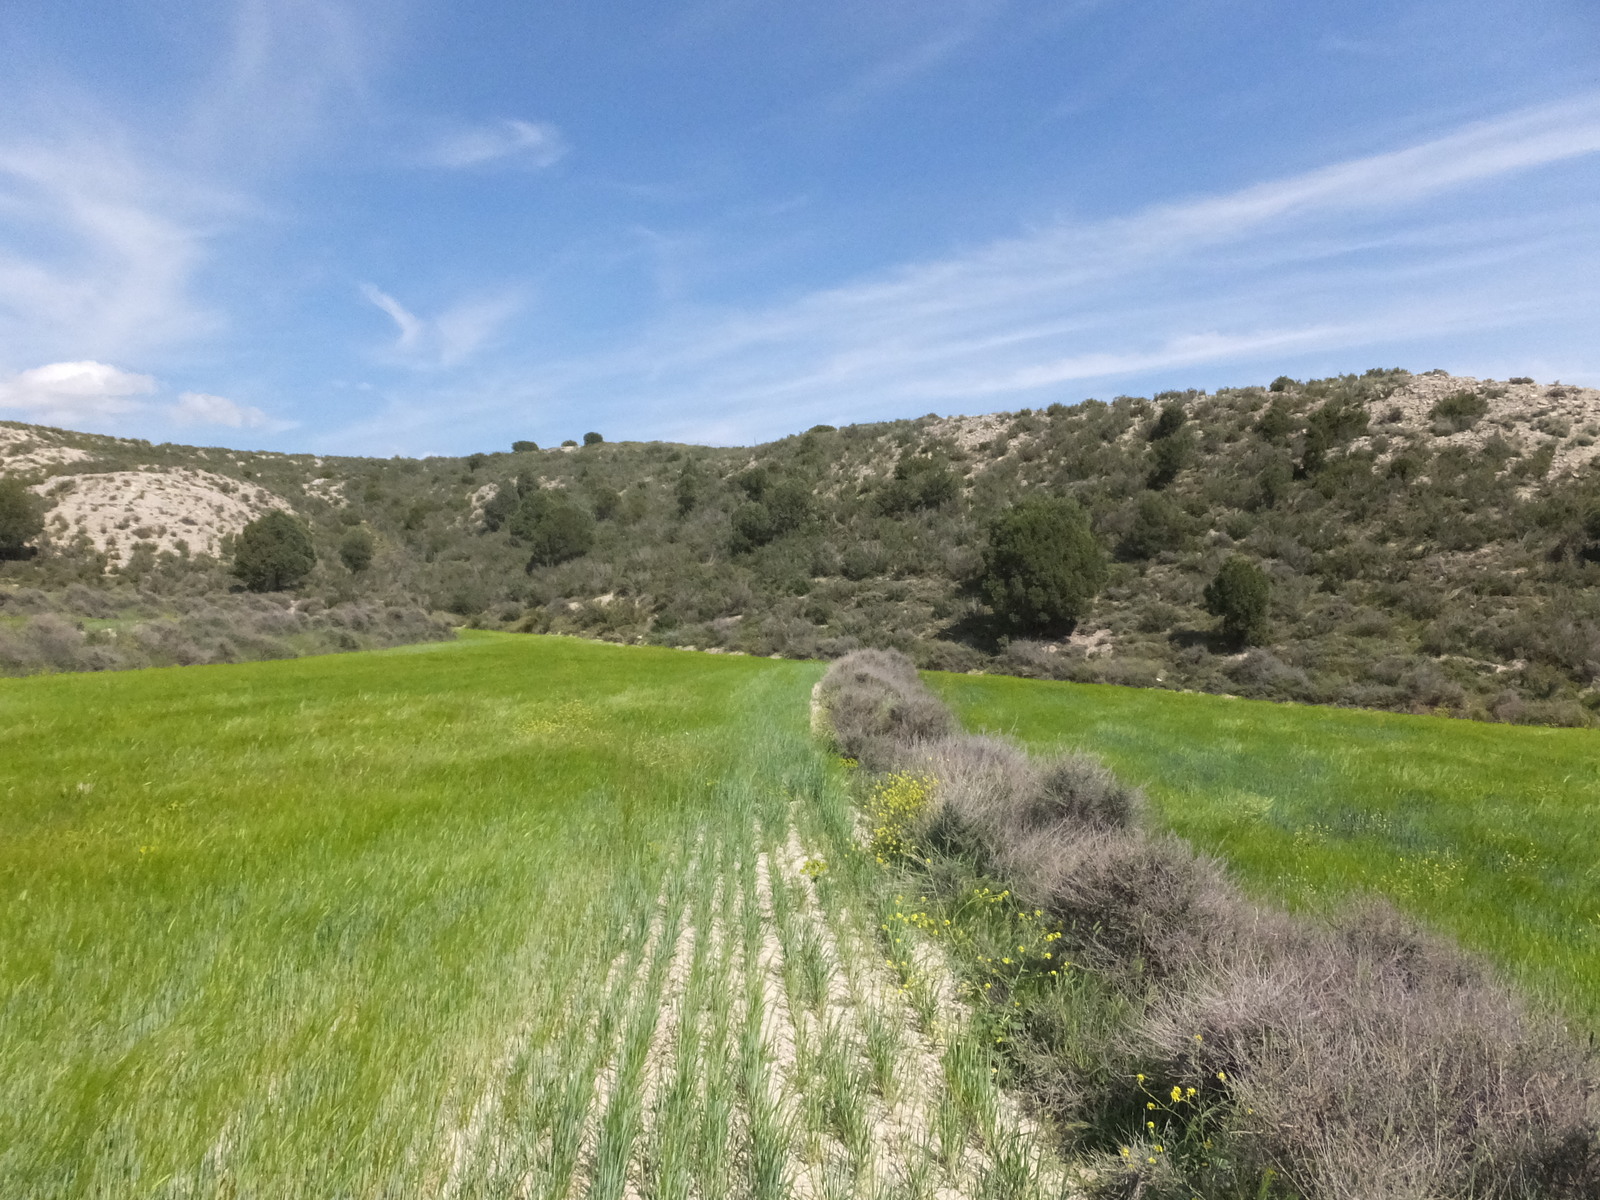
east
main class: Cropland
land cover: Barley
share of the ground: > 75 %
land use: Agriculture (excluding fallow land and kitchen gardens)
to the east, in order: Barley; Shrubland with sparse tree cover; Fences; Shrubland without tree cover; Artificial constructions in urban areas; Shrubland without tree cover
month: April
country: ES
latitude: 41.6104
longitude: -0.3737
